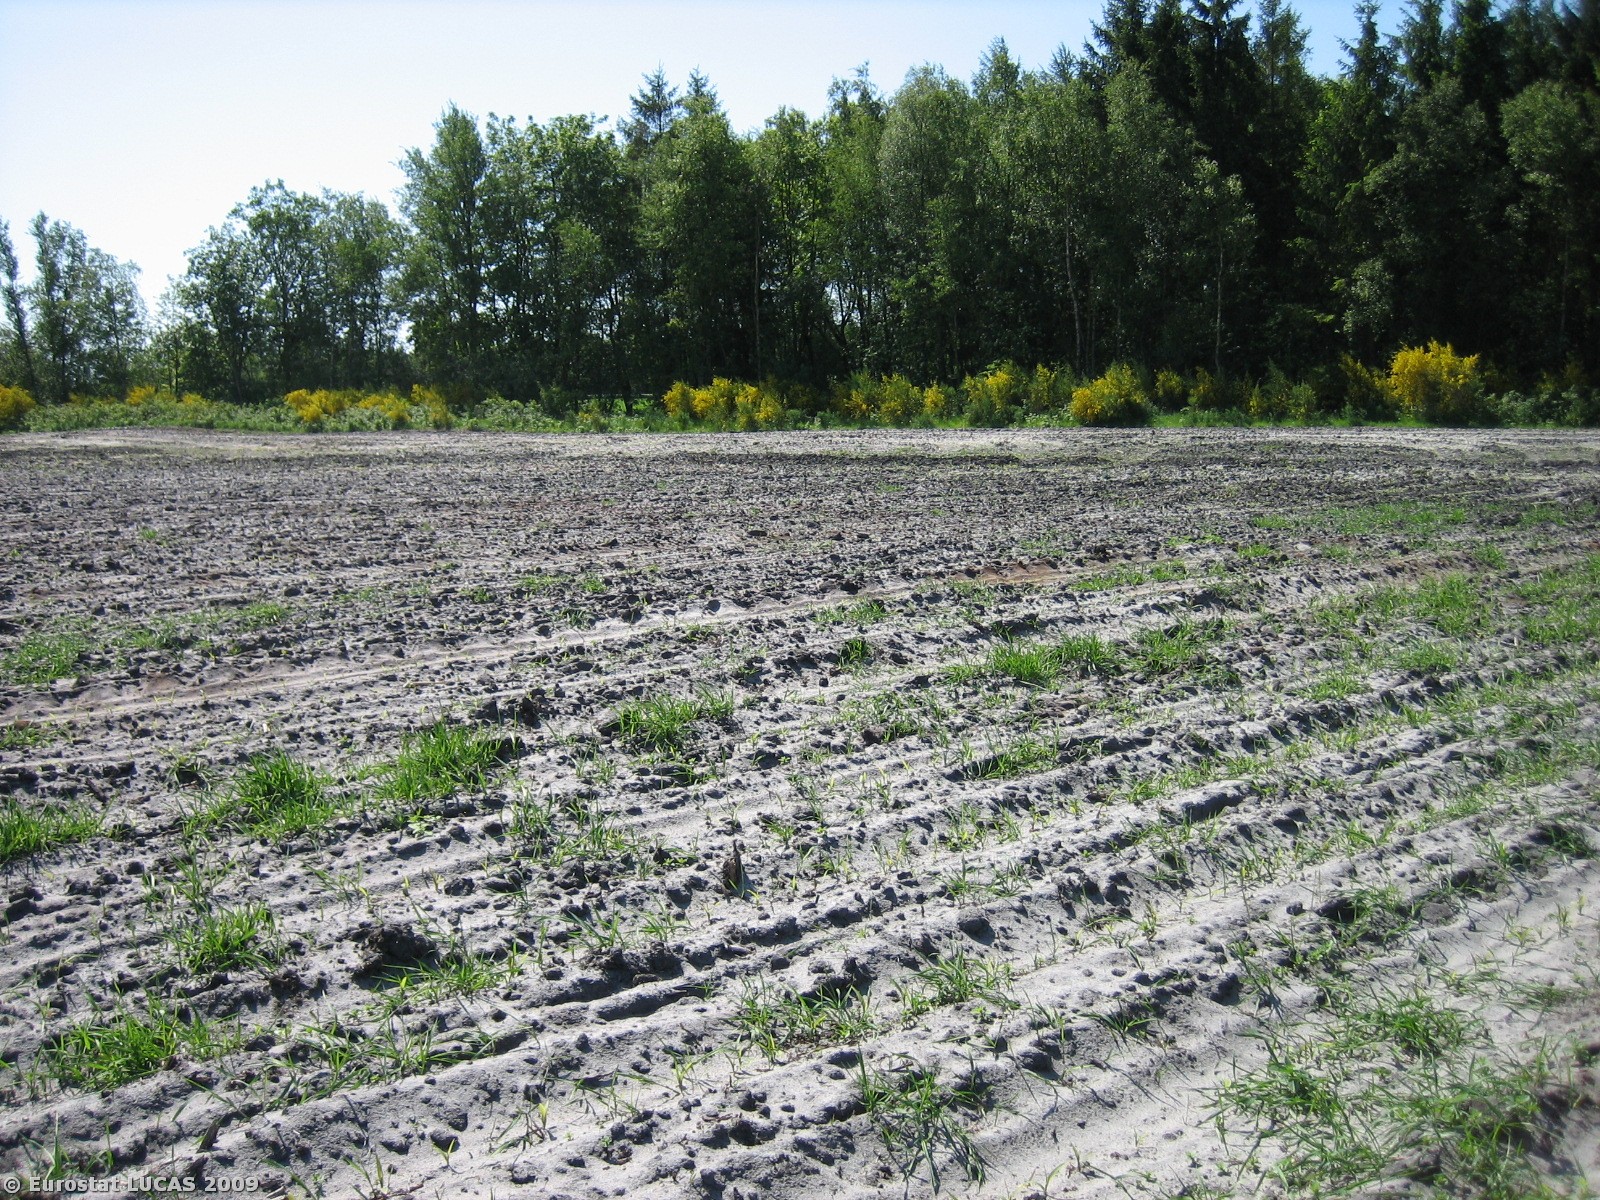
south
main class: Cropland
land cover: Maize
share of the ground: < 10 %
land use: Agriculture (excluding fallow land and kitchen gardens)
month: May
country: DK
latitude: 55.9316
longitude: 8.9287
